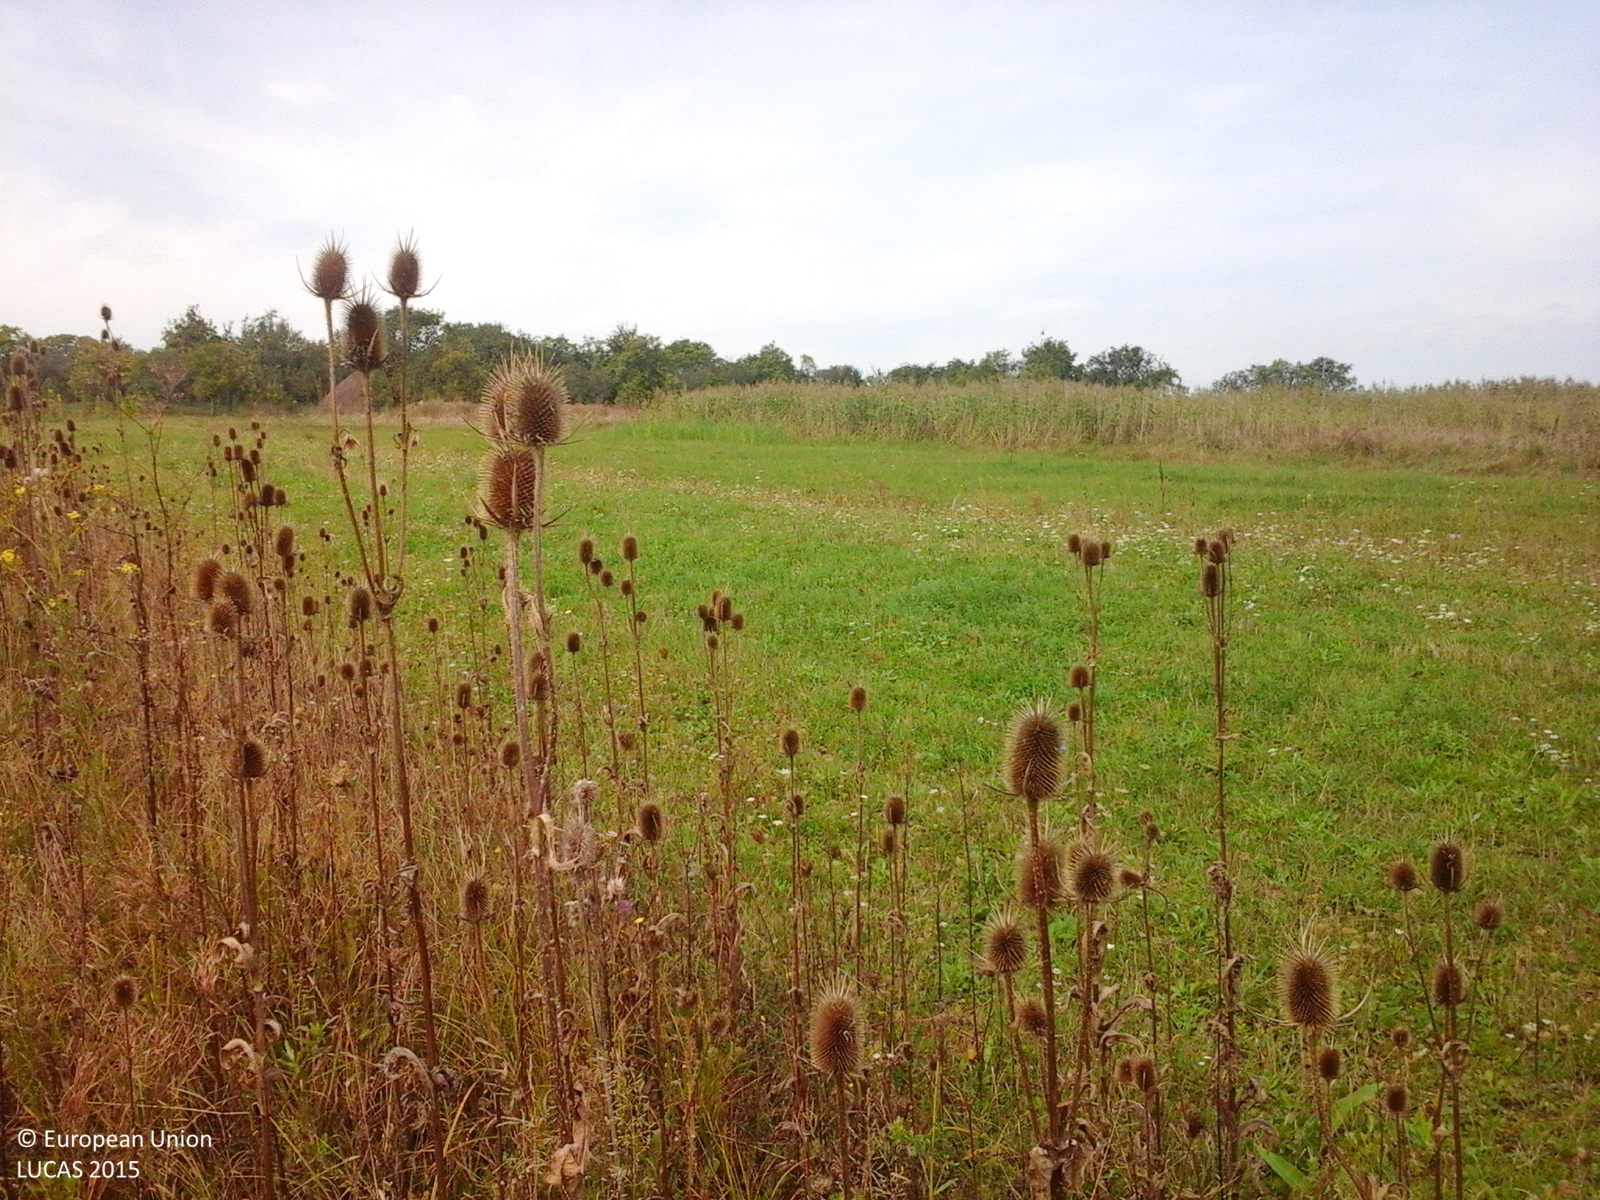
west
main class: Grassland
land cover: Spontaneously vegetated surfaces
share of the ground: > 75 %
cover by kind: herbaceous plants 100 %
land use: Fallow land
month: September
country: RO
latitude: 46.8363
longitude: 22.9488
